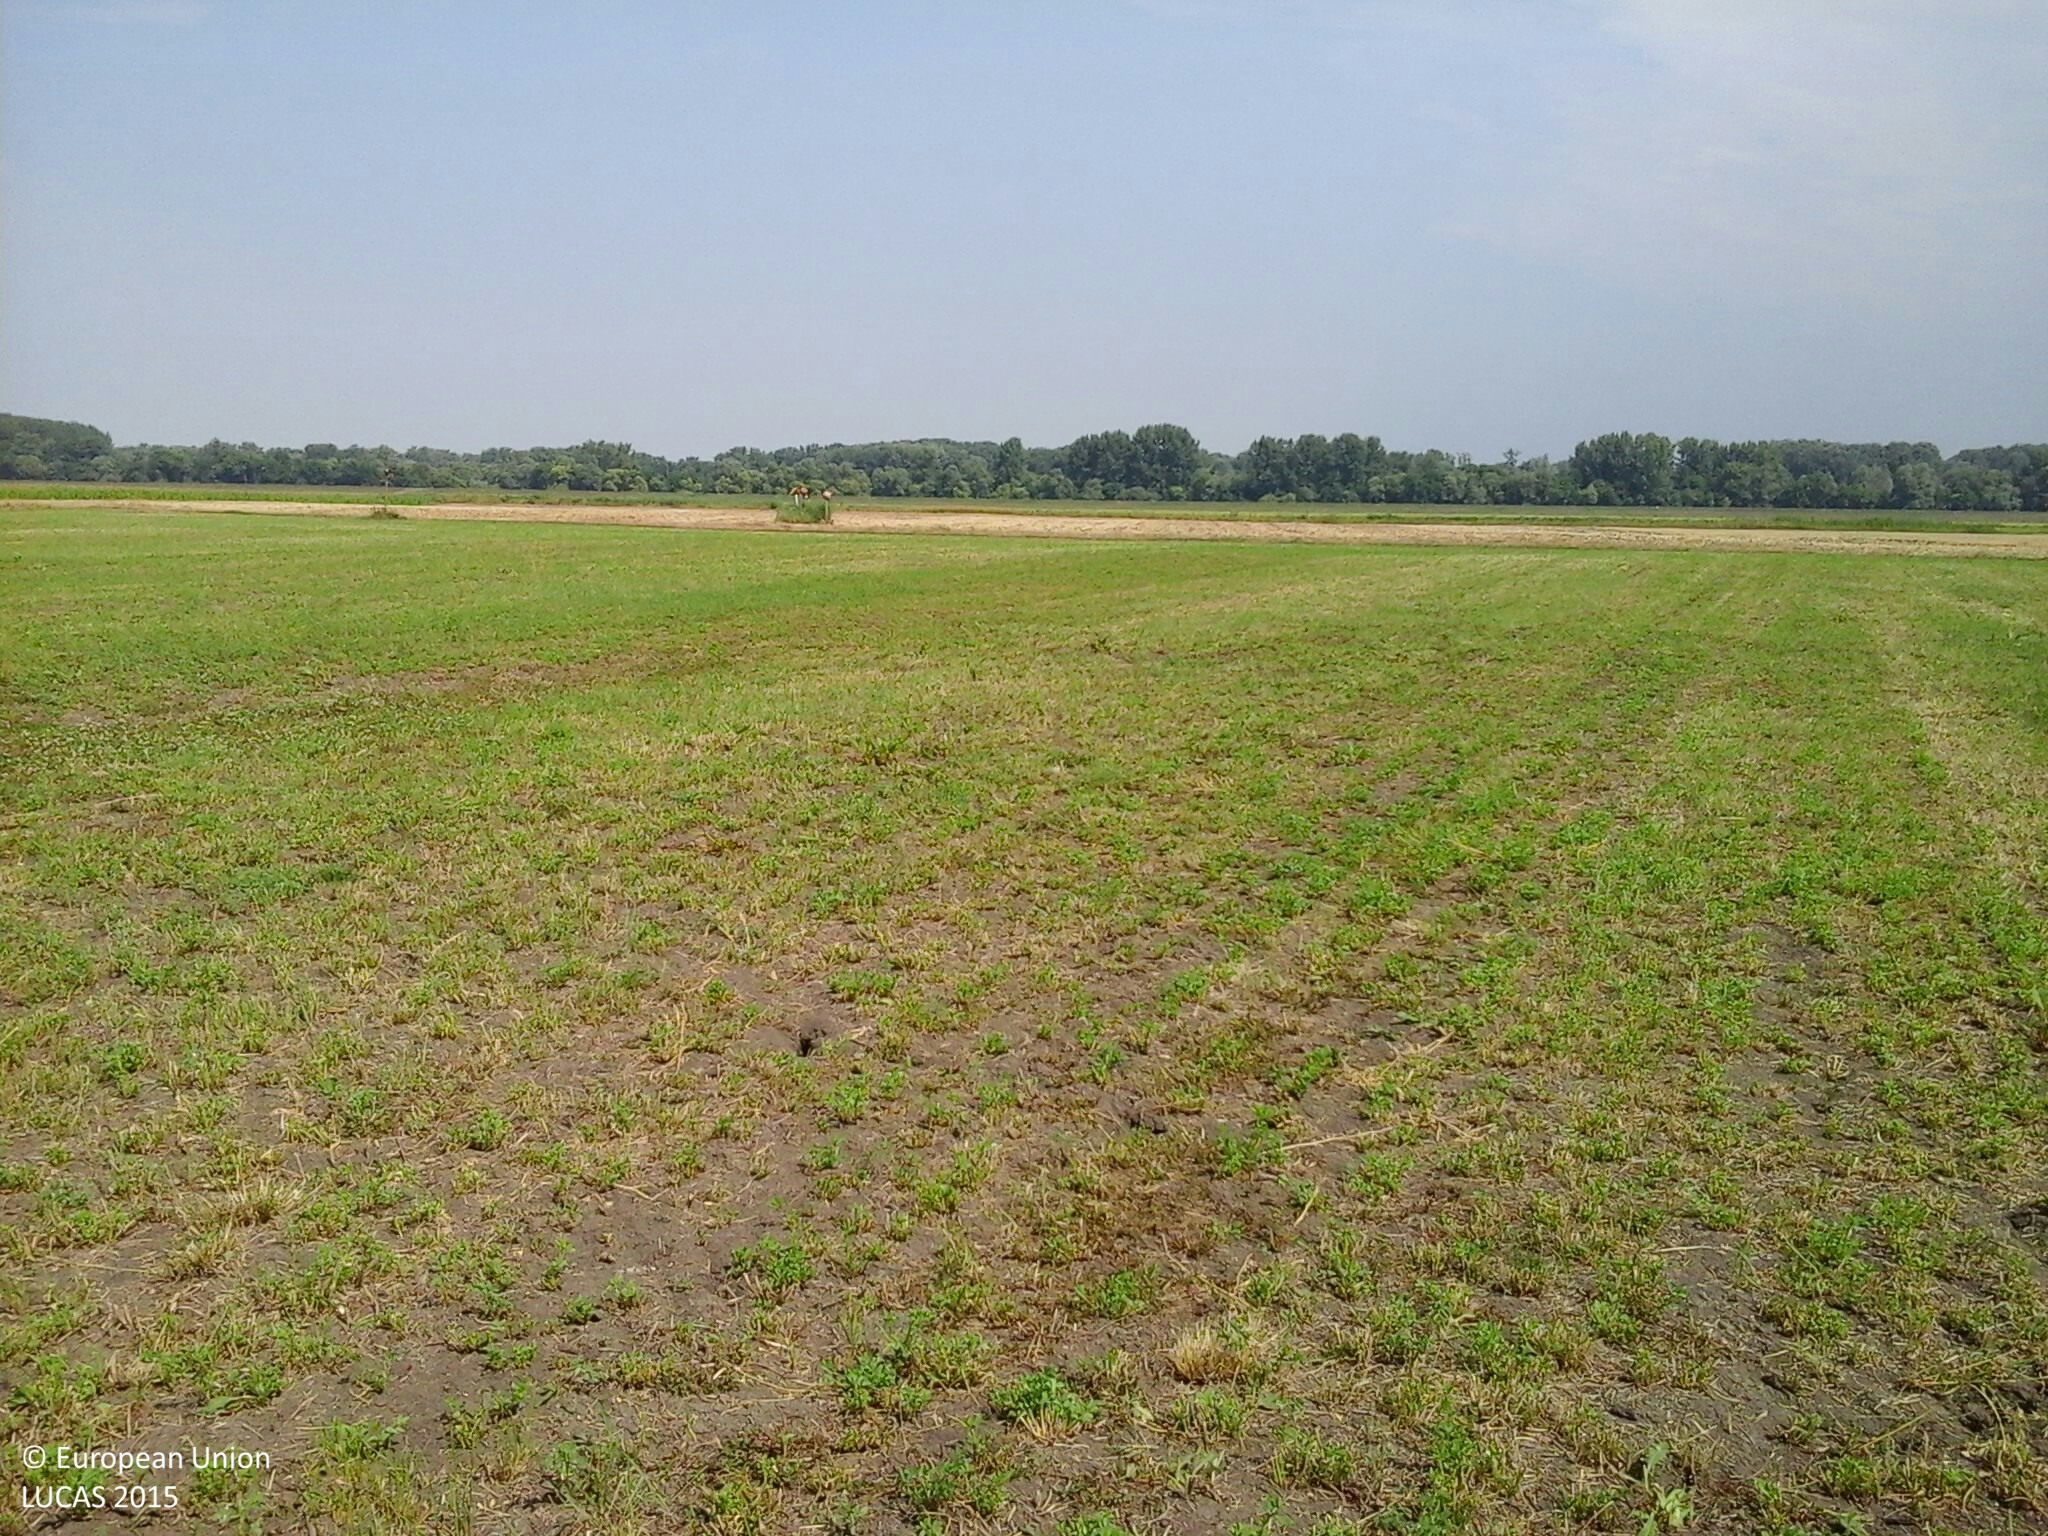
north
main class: Cropland
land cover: Lucerne
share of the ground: 50 - 75 %
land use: Agriculture (excluding fallow land and kitchen gardens)
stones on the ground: < 10 %
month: August
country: HU
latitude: 47.7096
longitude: 20.9798
